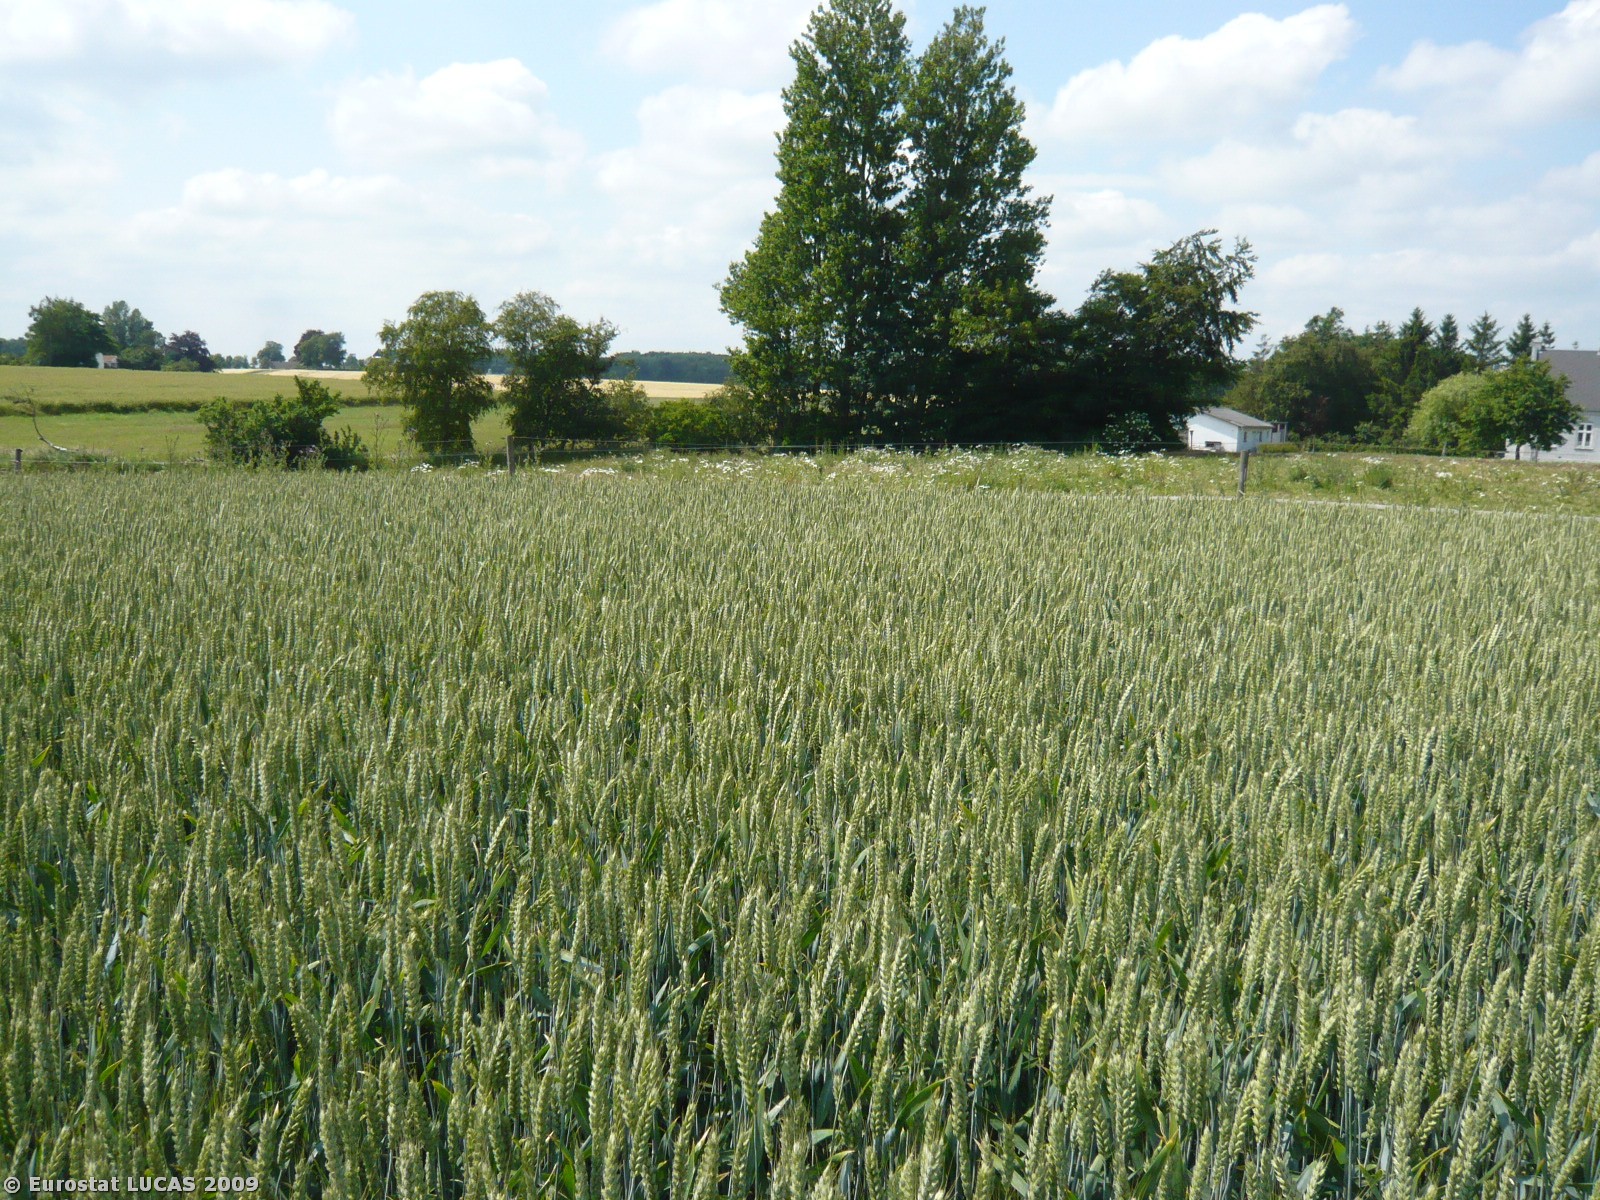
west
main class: Cropland
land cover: Common wheat
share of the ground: > 75 %
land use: Agriculture (excluding fallow land and kitchen gardens)
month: June
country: DK
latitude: 55.2874
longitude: 10.6450
